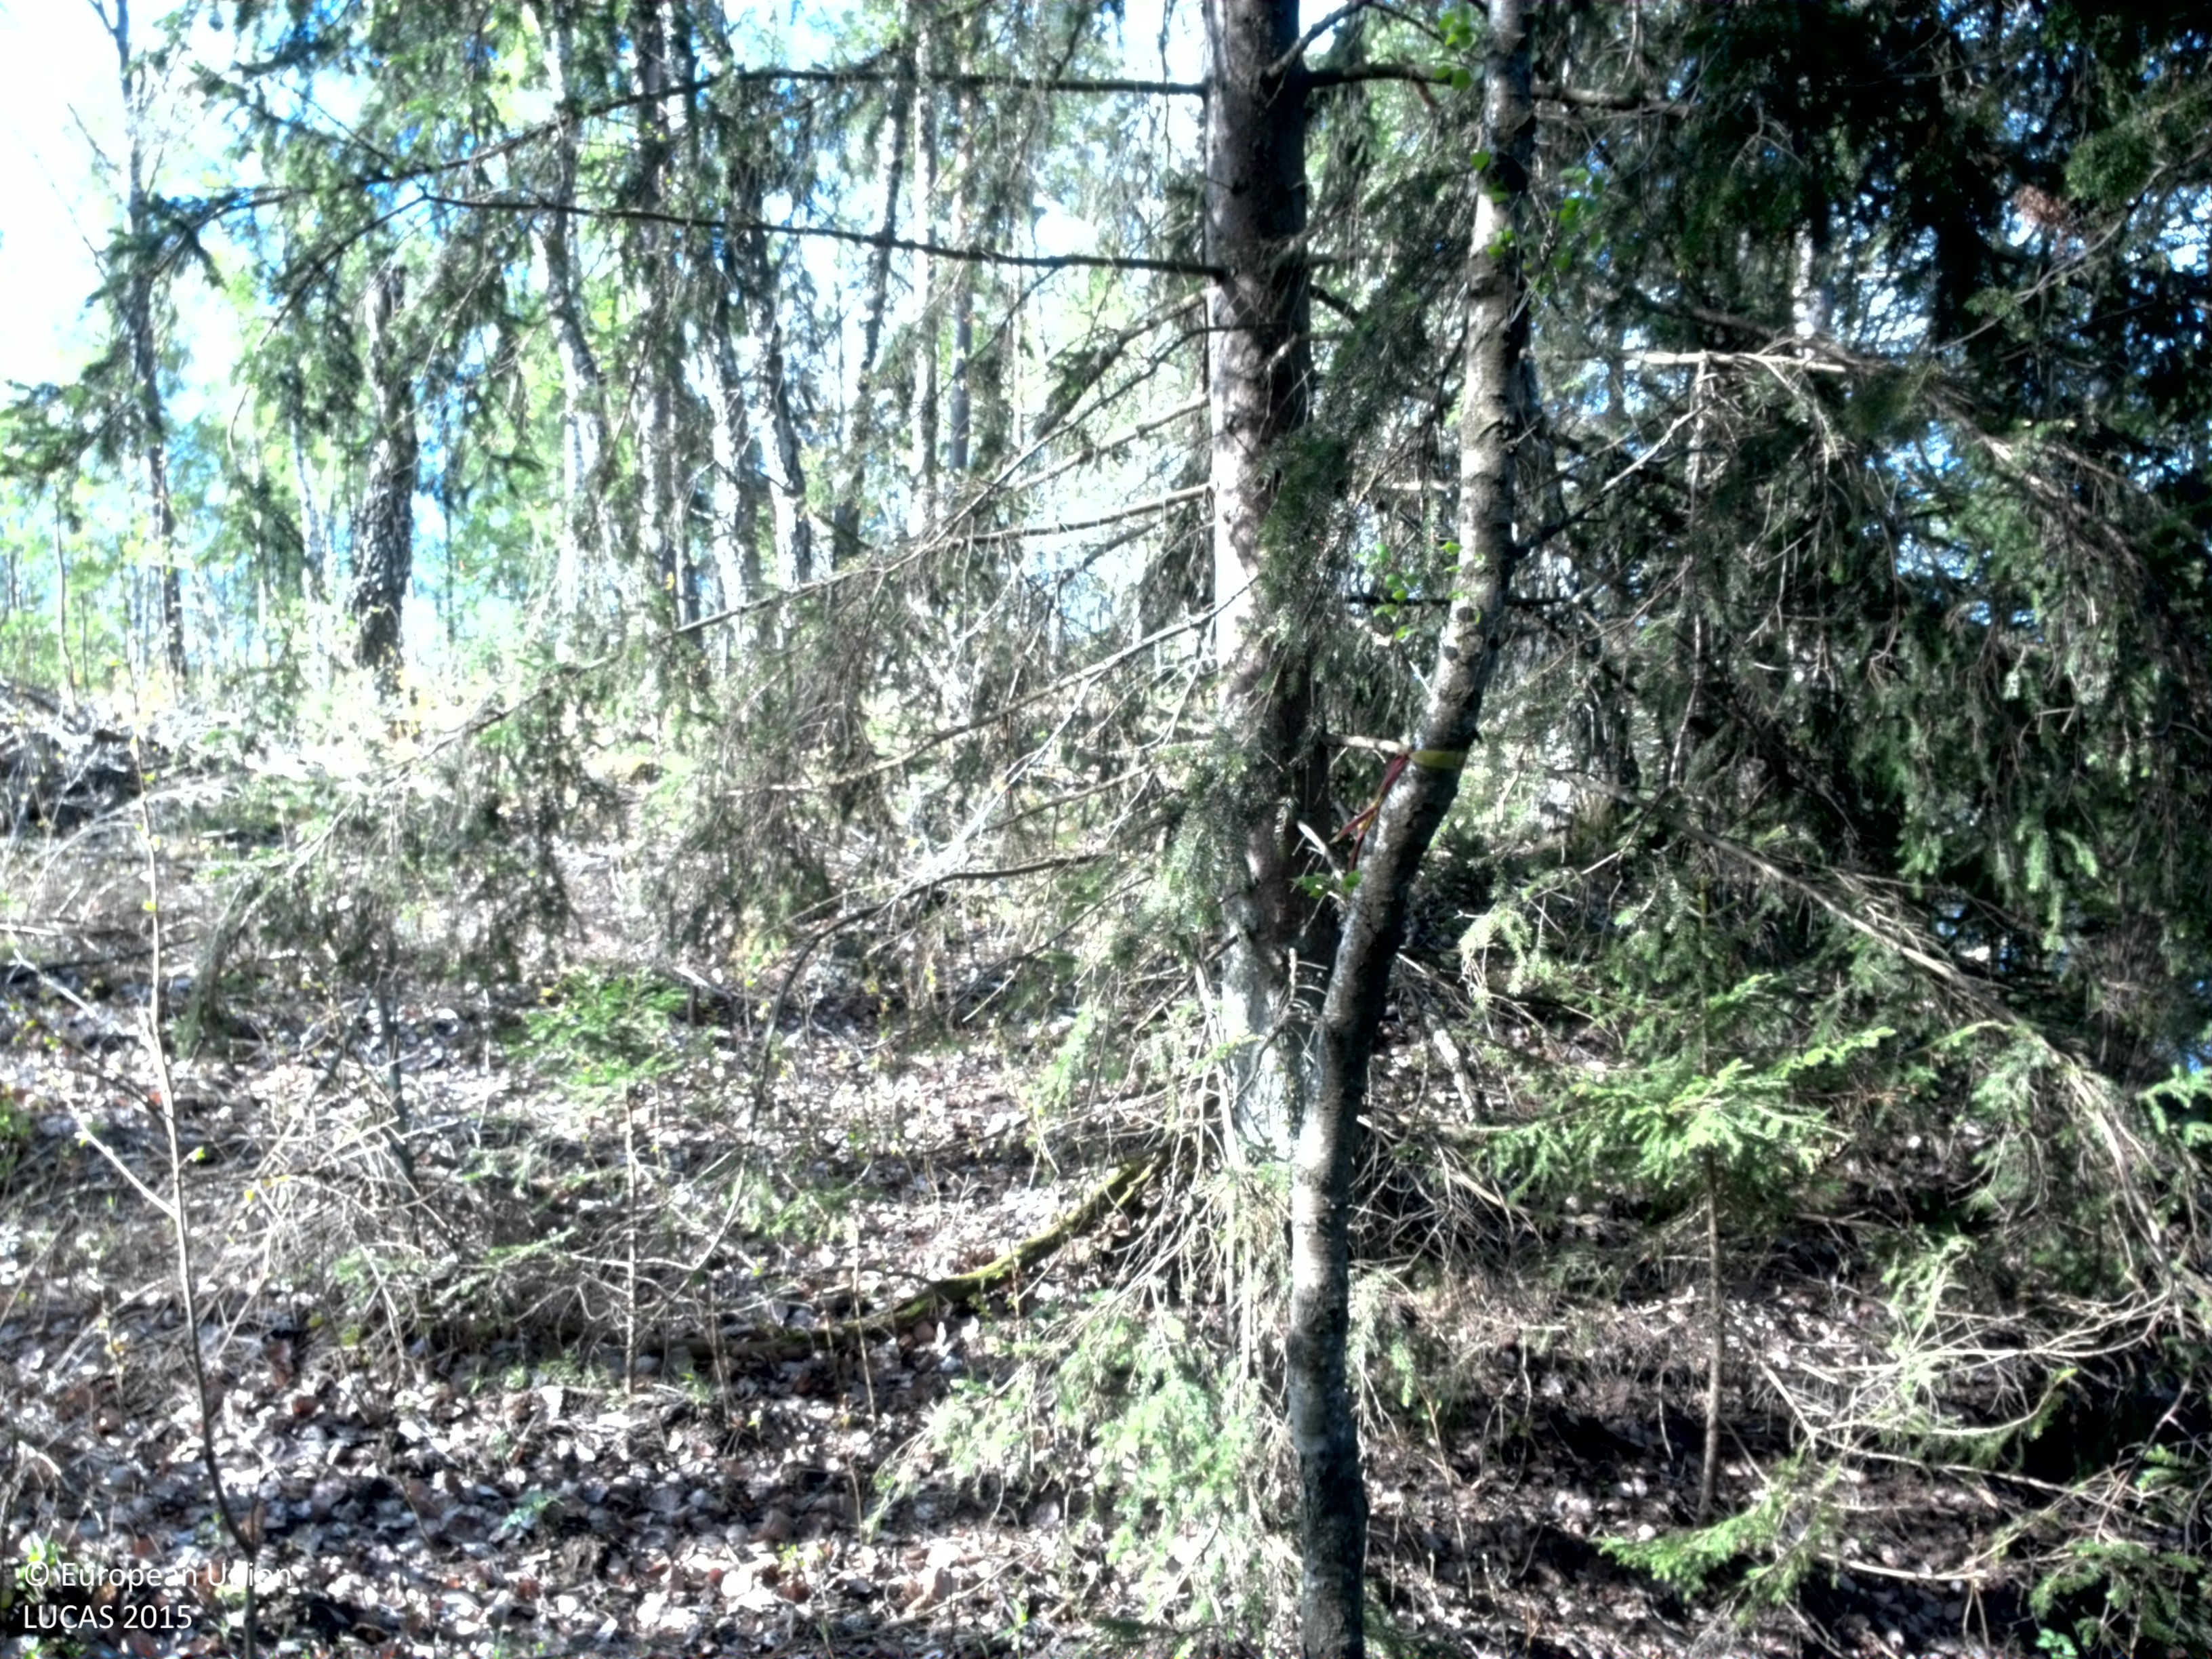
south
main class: Woodland
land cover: Broadleaved woodland
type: boreal forest
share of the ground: > 75 %
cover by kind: broadleaved forest trees 60 %, coniferous forest trees 20 %, herbaceous plants 10 %, lichens and mosses 10 %
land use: Forestry
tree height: > 5 m
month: May
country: SE
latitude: 56.6344
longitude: 15.3622
